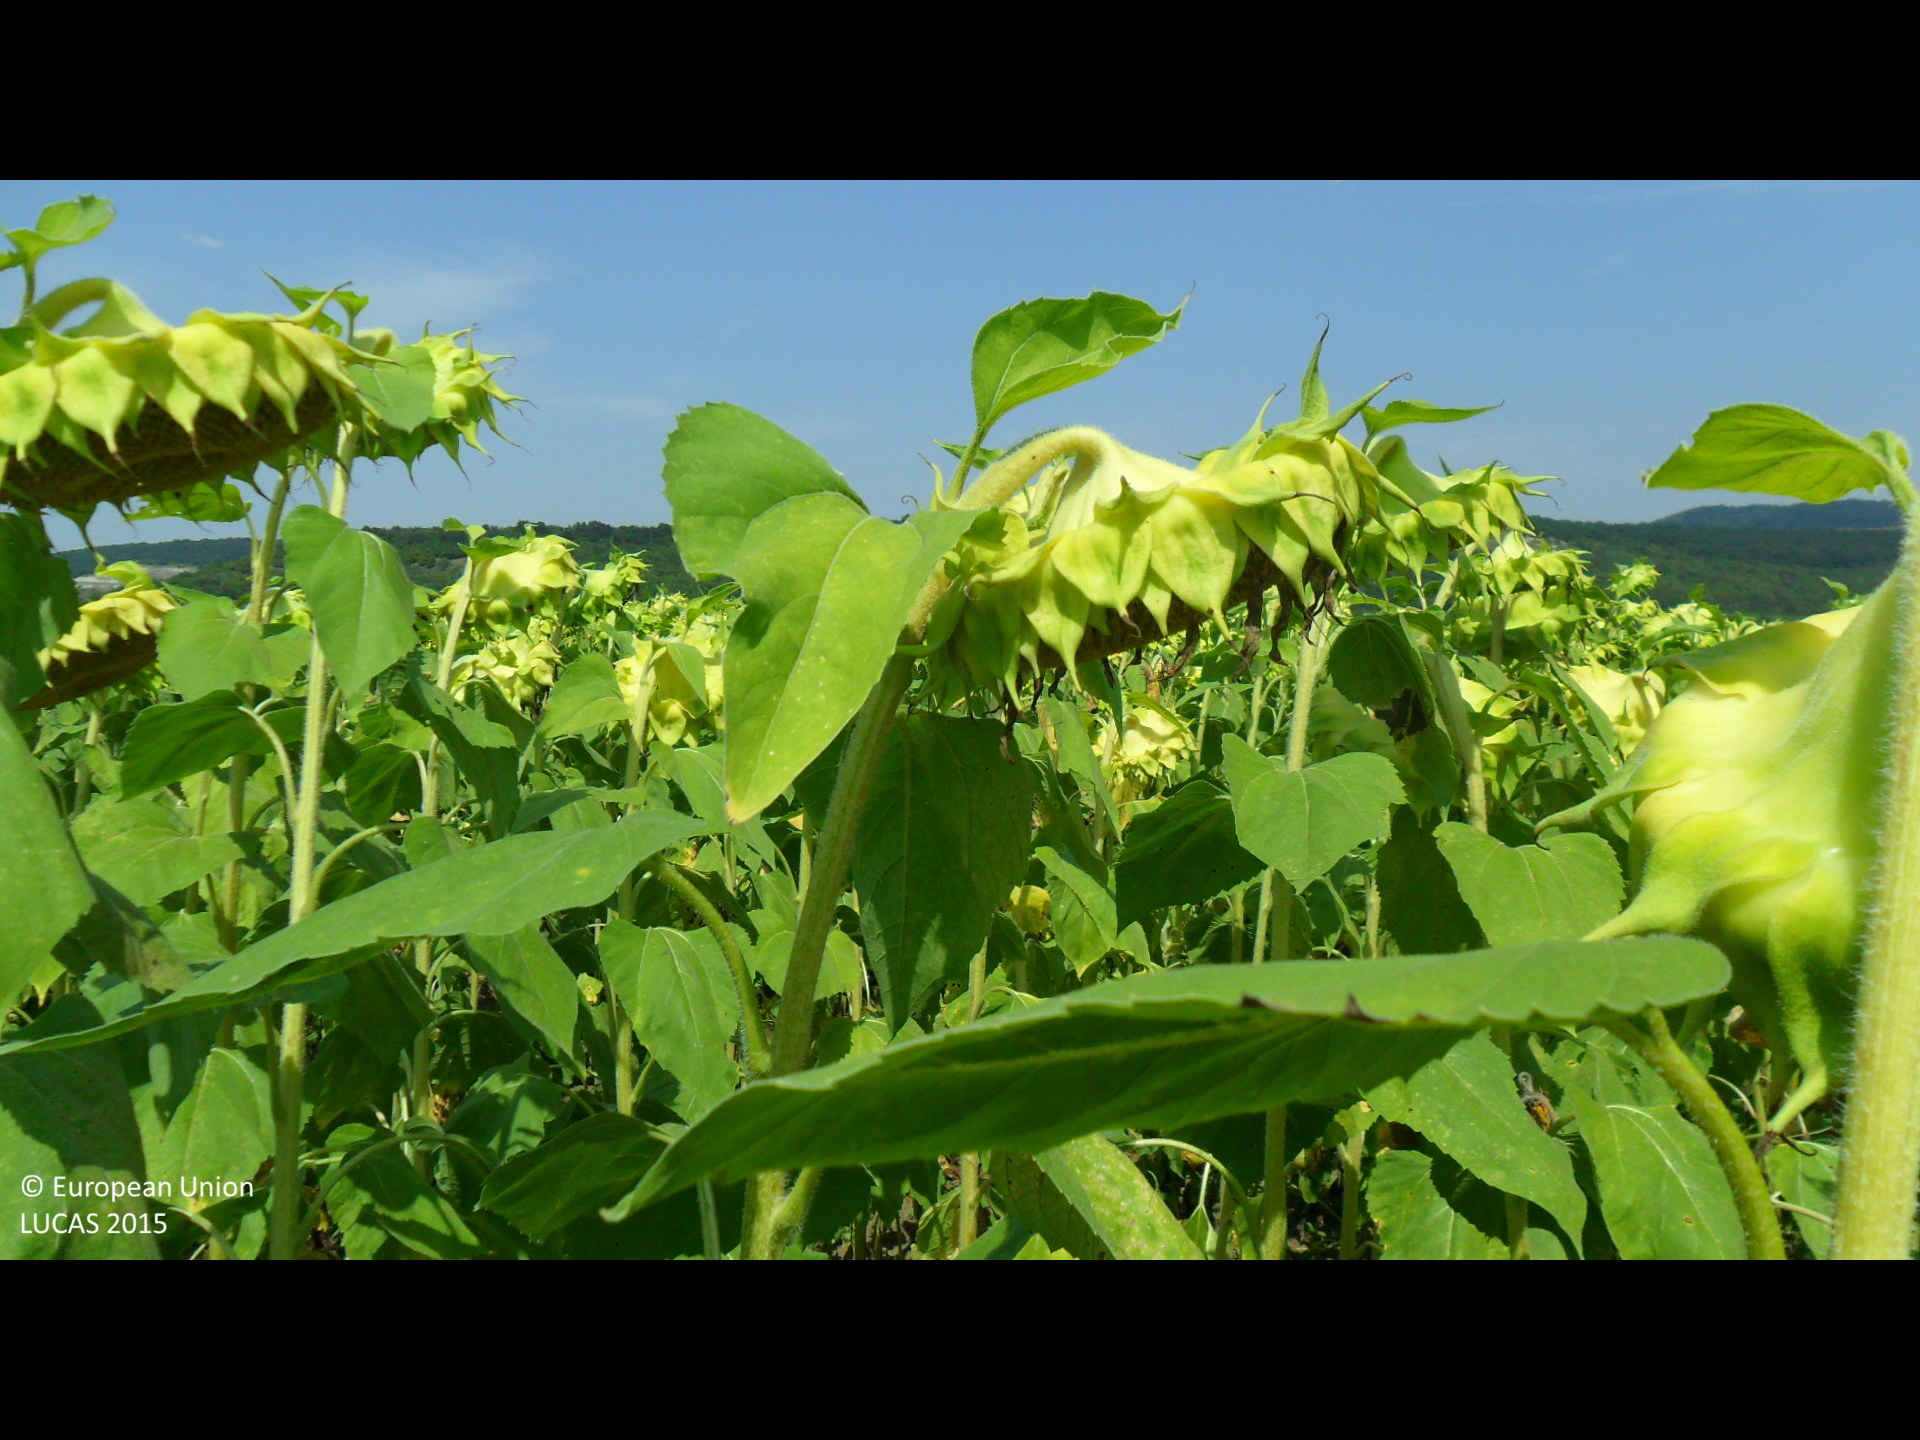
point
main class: Cropland
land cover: Sunflower
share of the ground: > 75 %
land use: Agriculture (excluding fallow land and kitchen gardens)
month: August
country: BG
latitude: 43.3284
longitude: 26.2902
